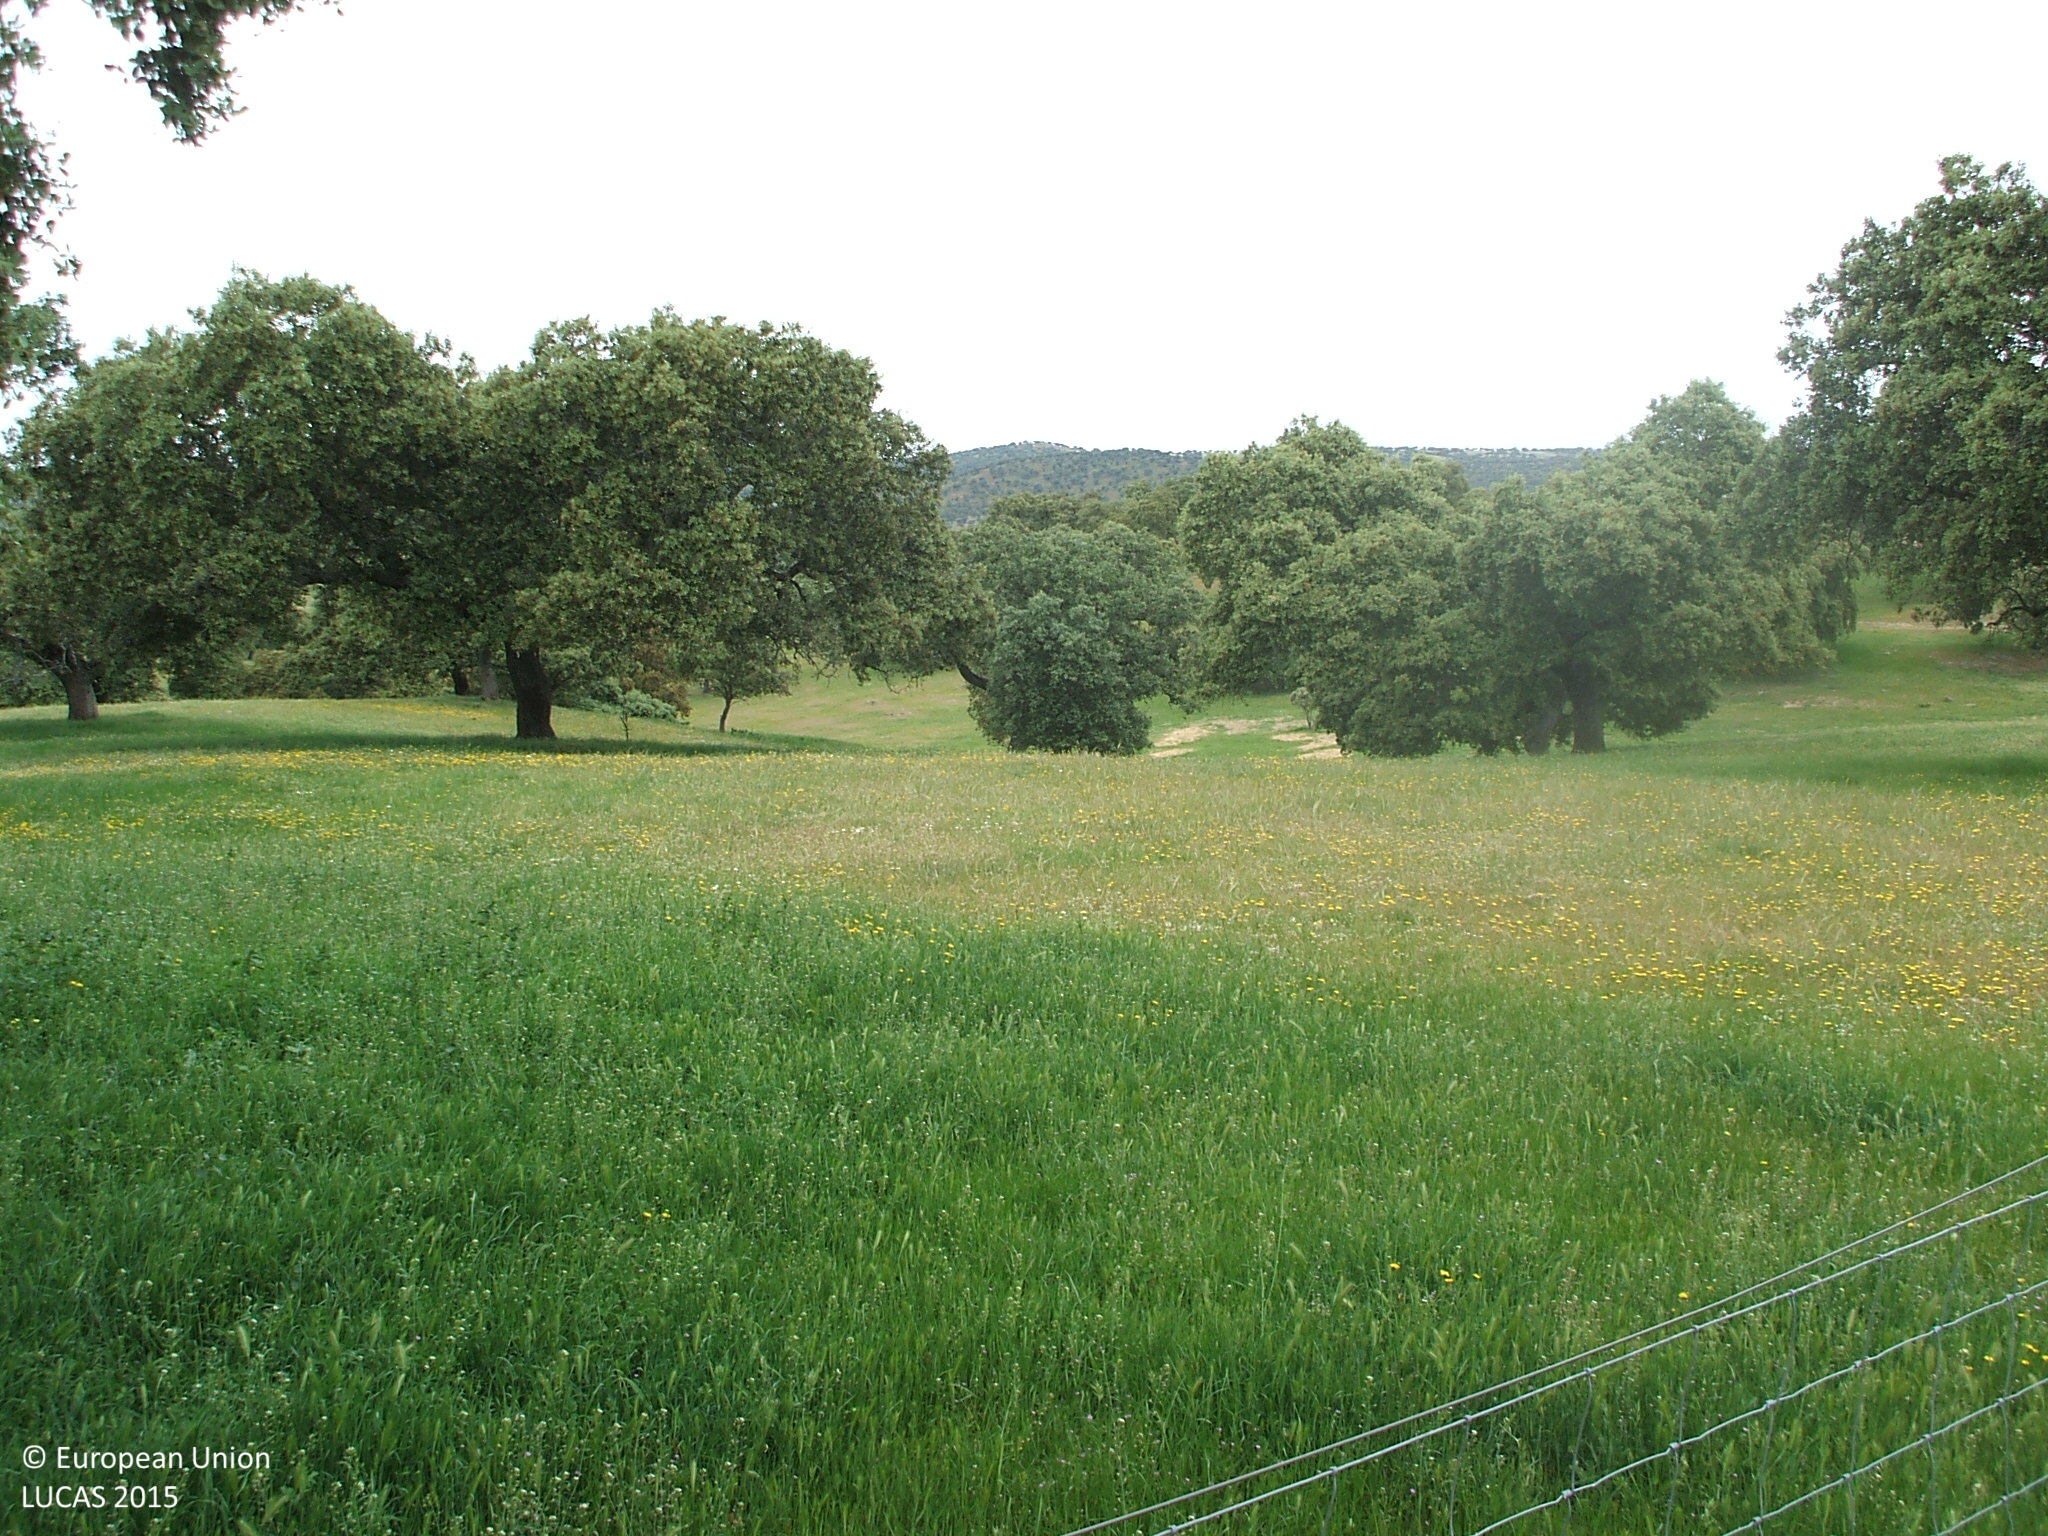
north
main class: Woodland
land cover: Broadleaved woodland
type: broadleaved evergreen forest
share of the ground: 10 - 25 %
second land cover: Grassland without tree/shrub cover
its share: > 75 %
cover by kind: herbaceous plants 80 %, broadleaved forest trees 20 %
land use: Forestry
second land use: Agriculture (excluding fallow land and kitchen gardens)
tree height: > 5 m
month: April
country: ES
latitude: 38.1722
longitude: -5.7753
